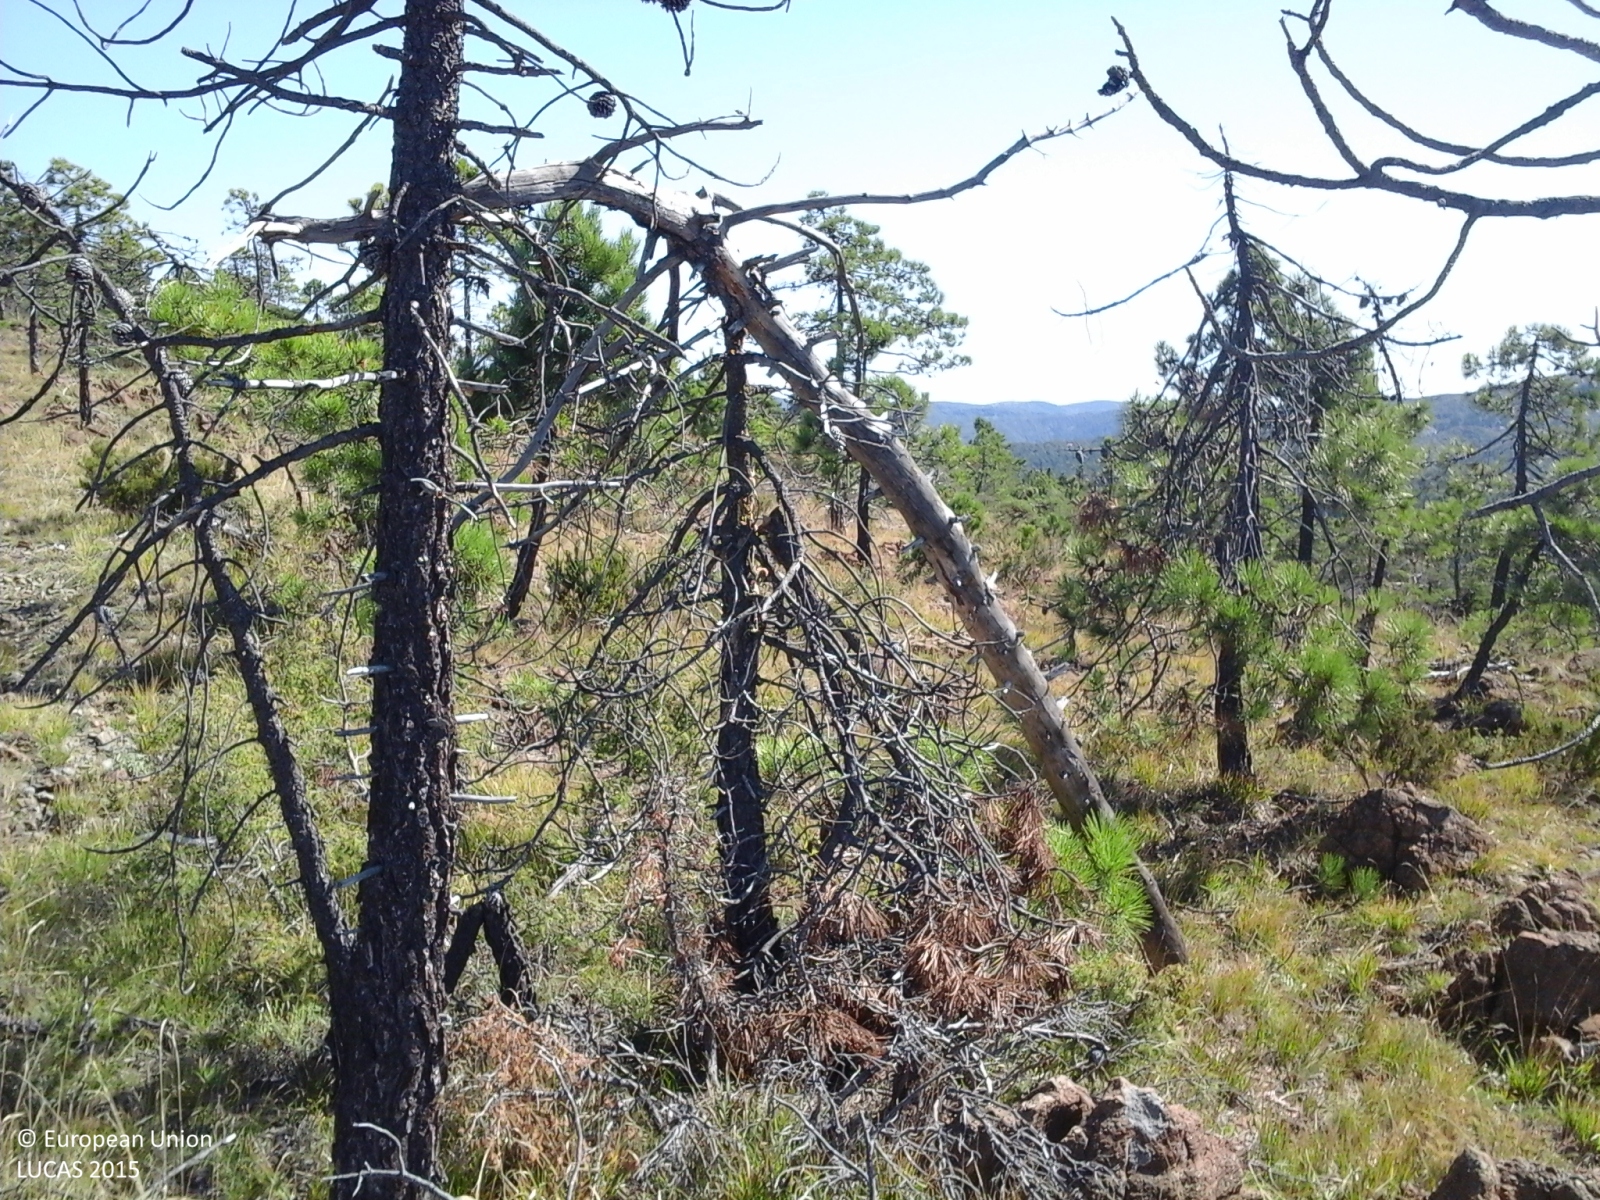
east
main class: Woodland
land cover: Pine dominated mixed woodland
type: coniferous forest of the mediterranean region
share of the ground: > 75 %
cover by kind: coniferous forest trees 75 %, broadleaved forest trees 25 %
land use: Semi-natural and natural areas not in use
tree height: > 5 m
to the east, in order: Pine dominated mixed woodland
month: September
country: IT
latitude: 44.5025
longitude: 8.5316
